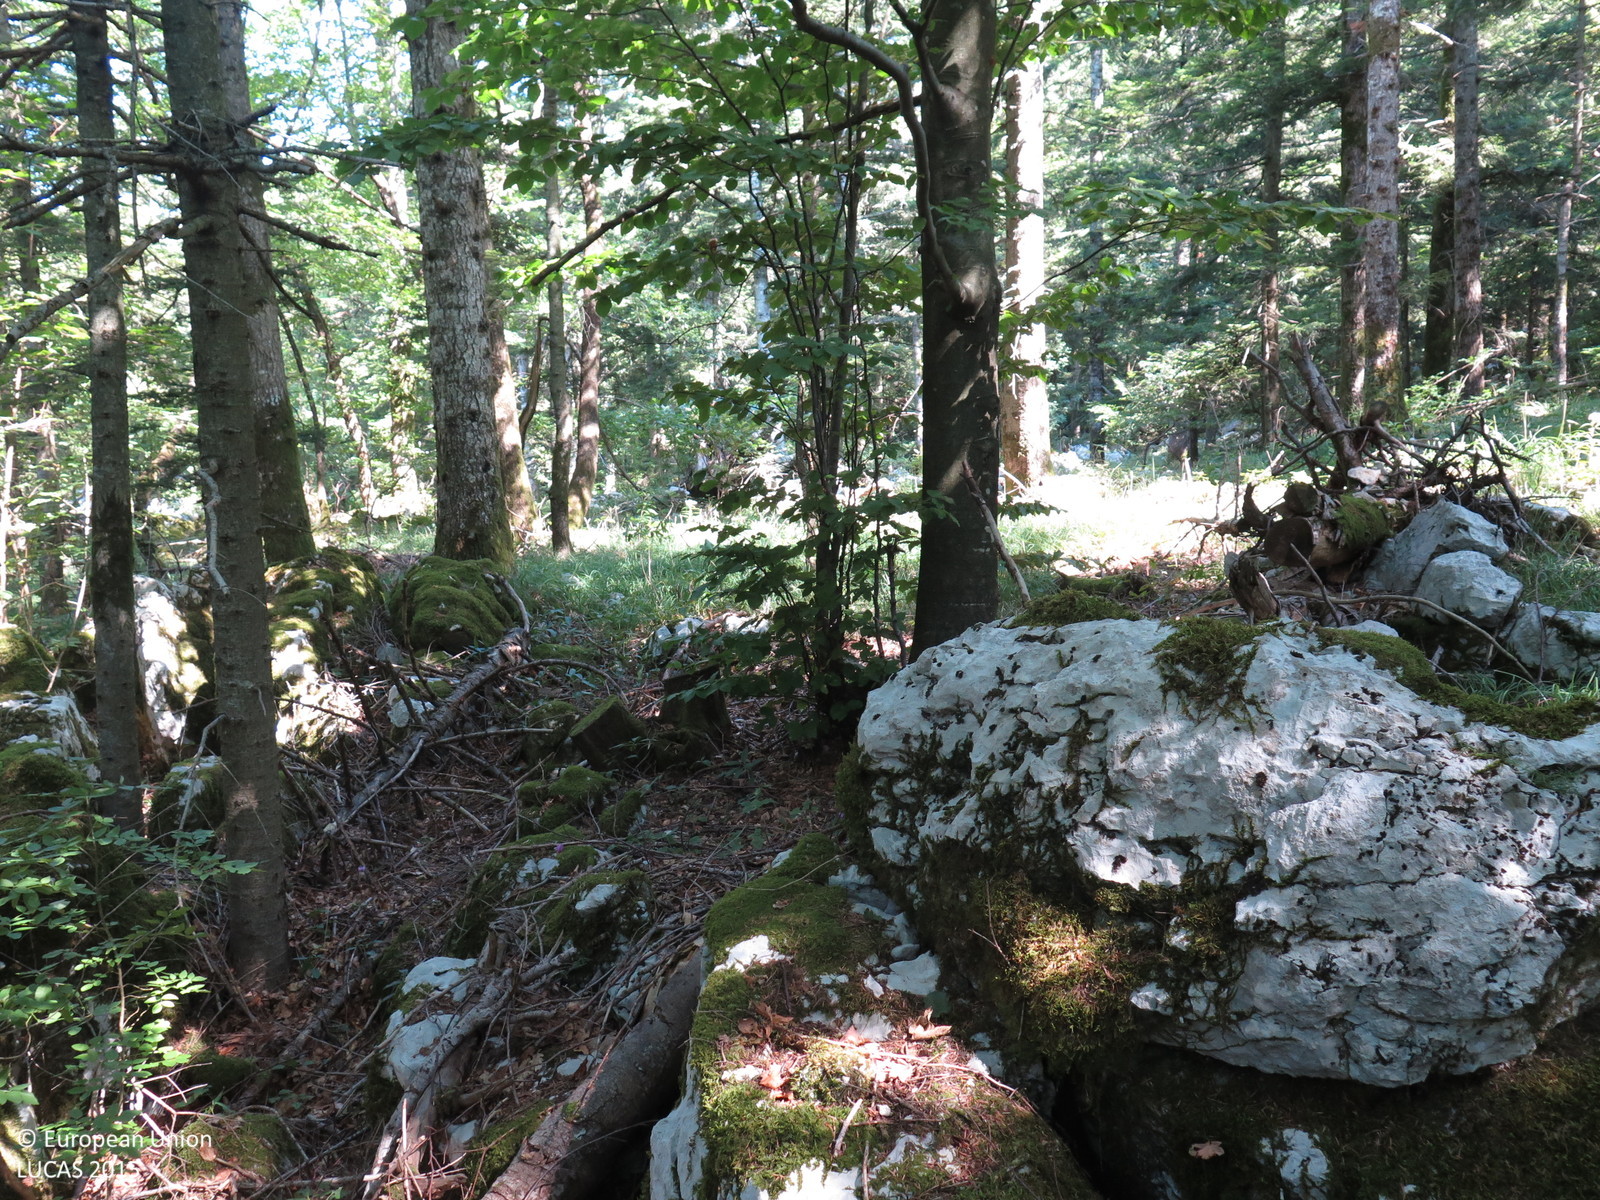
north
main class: Woodland
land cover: Other mixed woodland
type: mountainous beech forest
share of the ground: > 75 %
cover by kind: coniferous forest trees 75 %, broadleaved forest trees 25 %
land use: Forestry
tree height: > 5 m
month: August
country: HR
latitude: 45.1981
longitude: 14.7684
